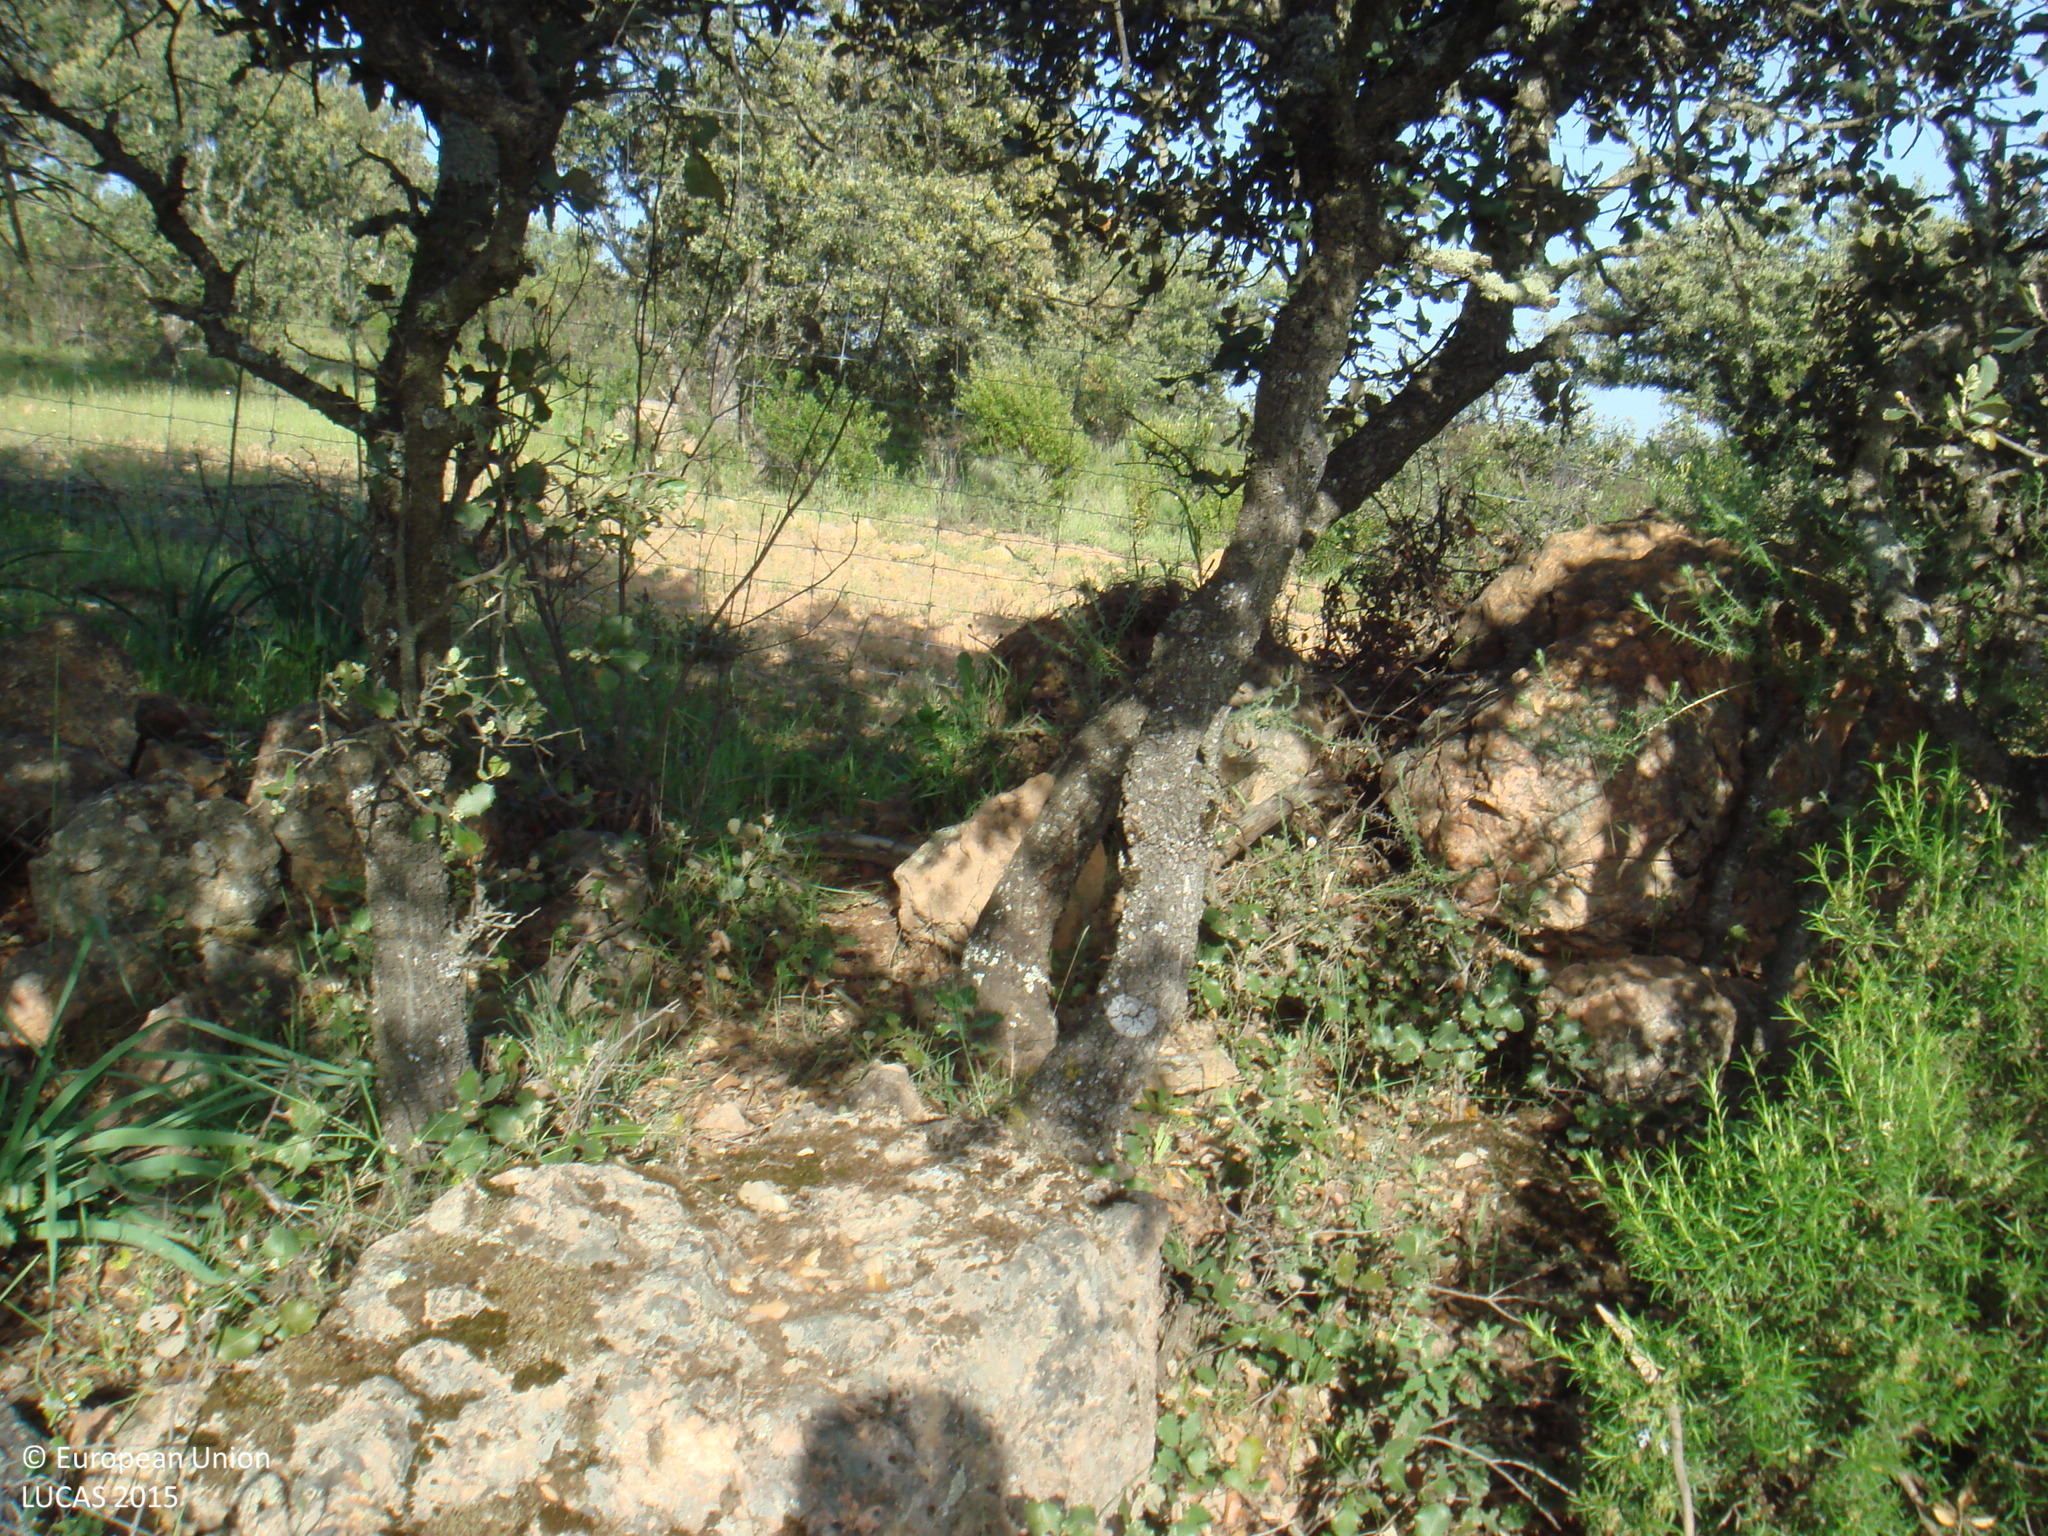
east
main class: Woodland
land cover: Broadleaved woodland
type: broadleaved evergreen forest
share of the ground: > 75 %
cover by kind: broadleaved forest trees 75 %, herbaceous plants 15 %, shrubs 10 %
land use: Forestry
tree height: > 5 m
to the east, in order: Broadleaved woodland; Fences; Other structural elements; Tracks; Broadleaved woodland
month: April
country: ES
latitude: 38.1642
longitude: -5.2631
